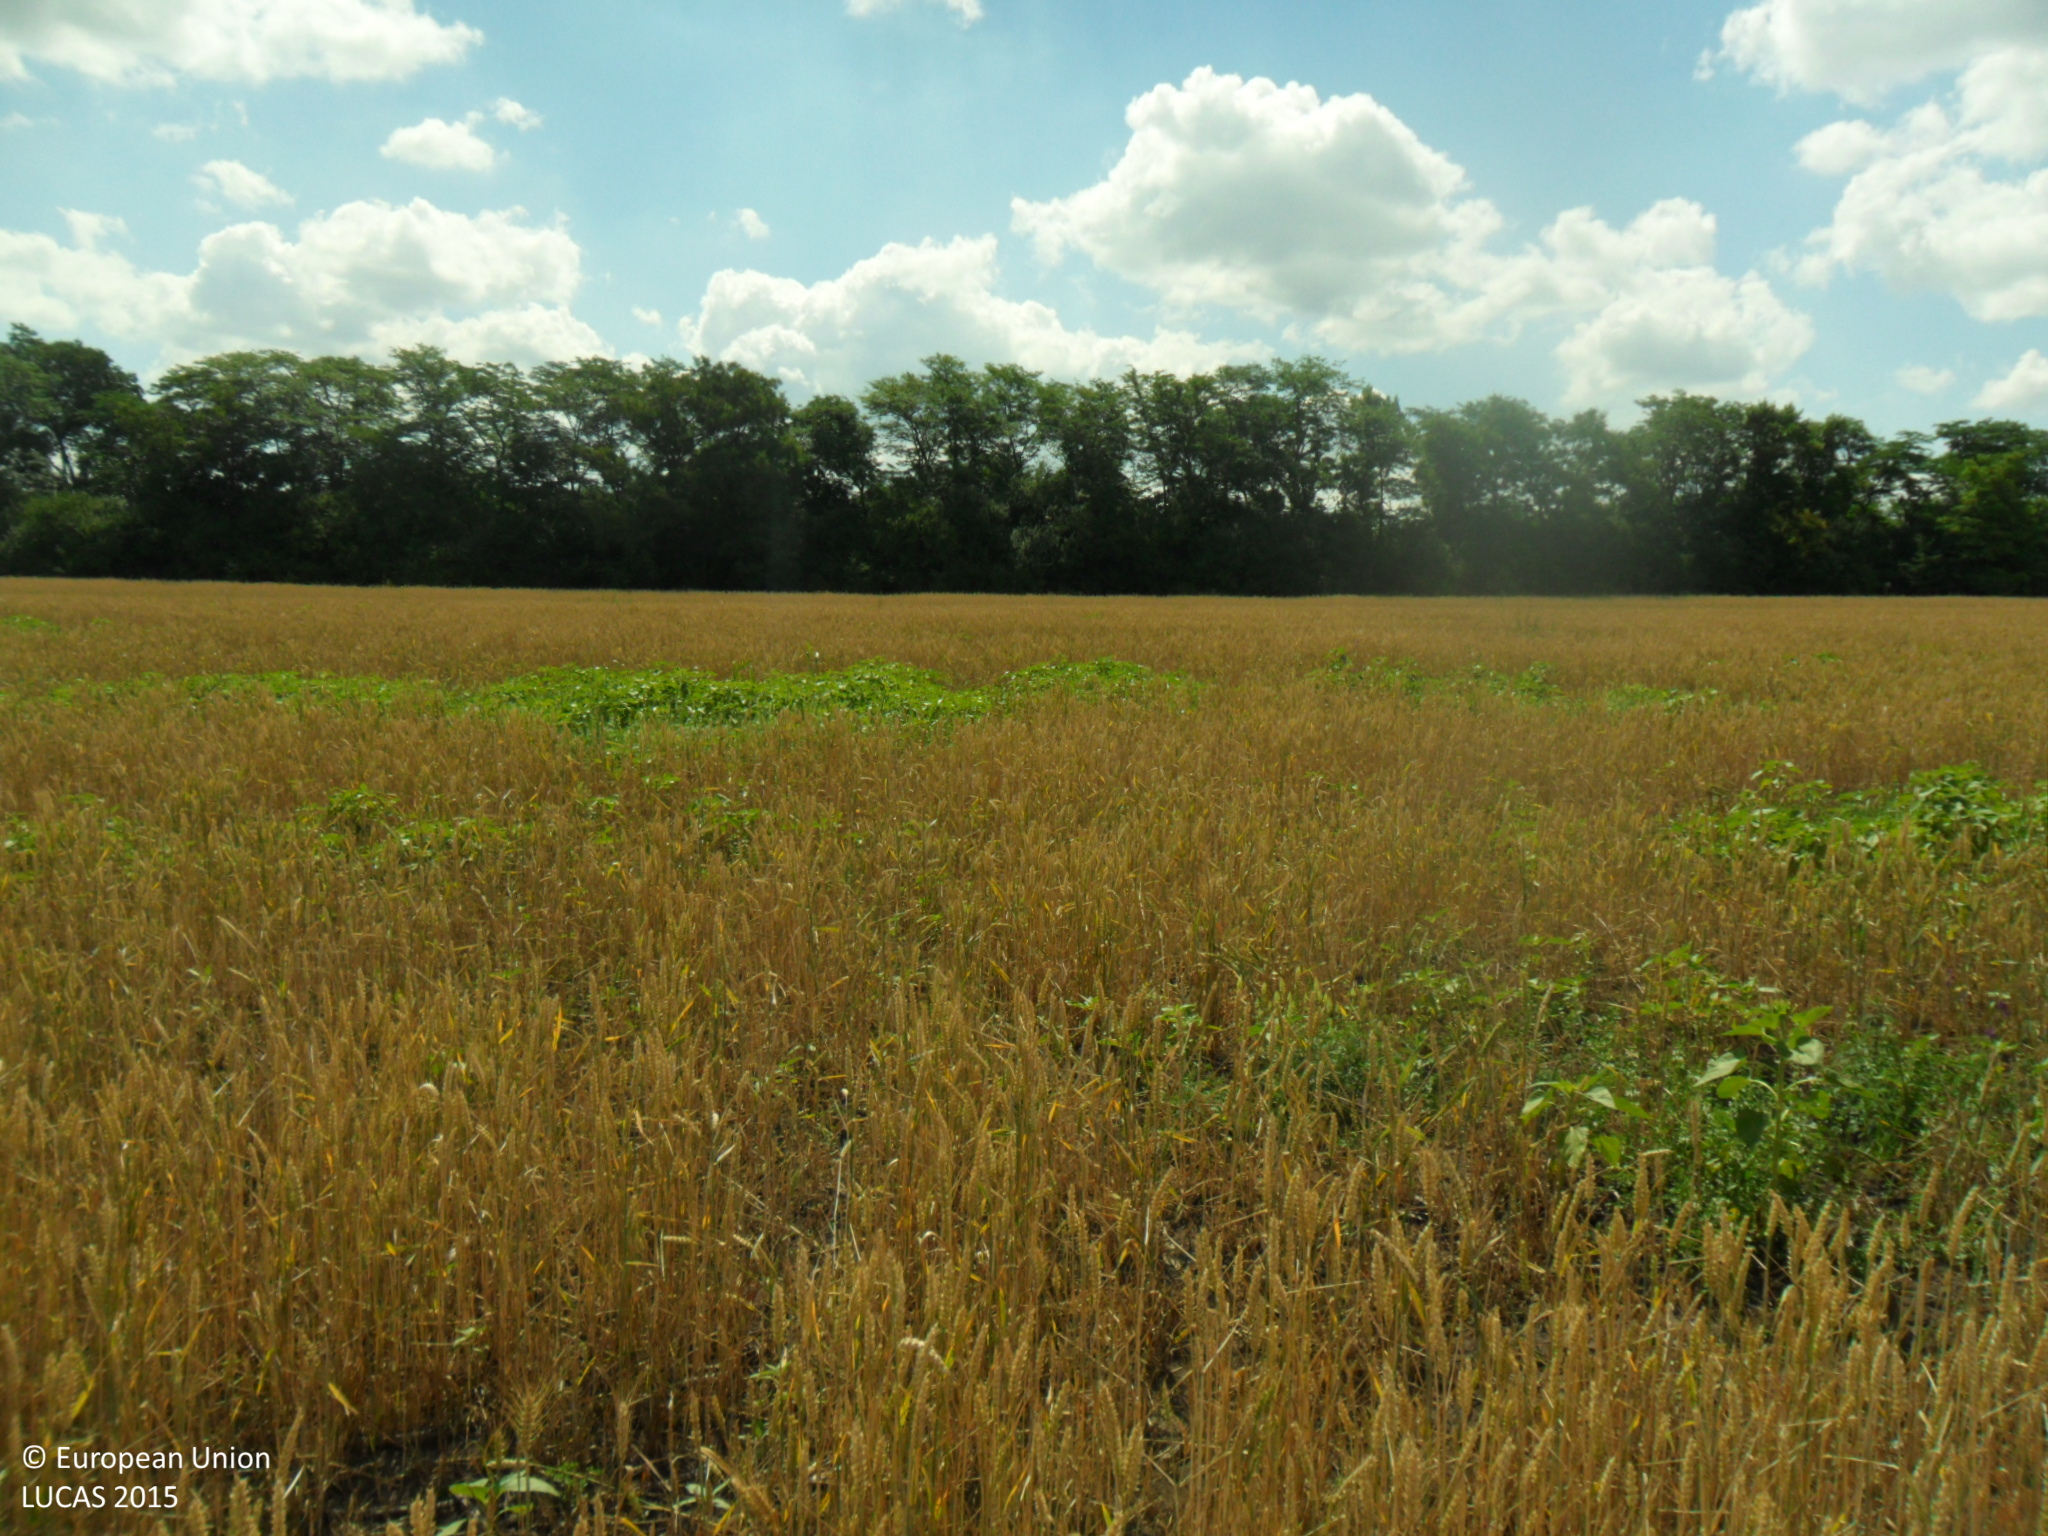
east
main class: Cropland
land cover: Common wheat
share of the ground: > 75 %
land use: Agriculture (excluding fallow land and kitchen gardens)
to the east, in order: Common wheat; Grass margins; Broadleaved woodland; Grass margins; Maize
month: June
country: BG
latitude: 43.3573
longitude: 27.0072
